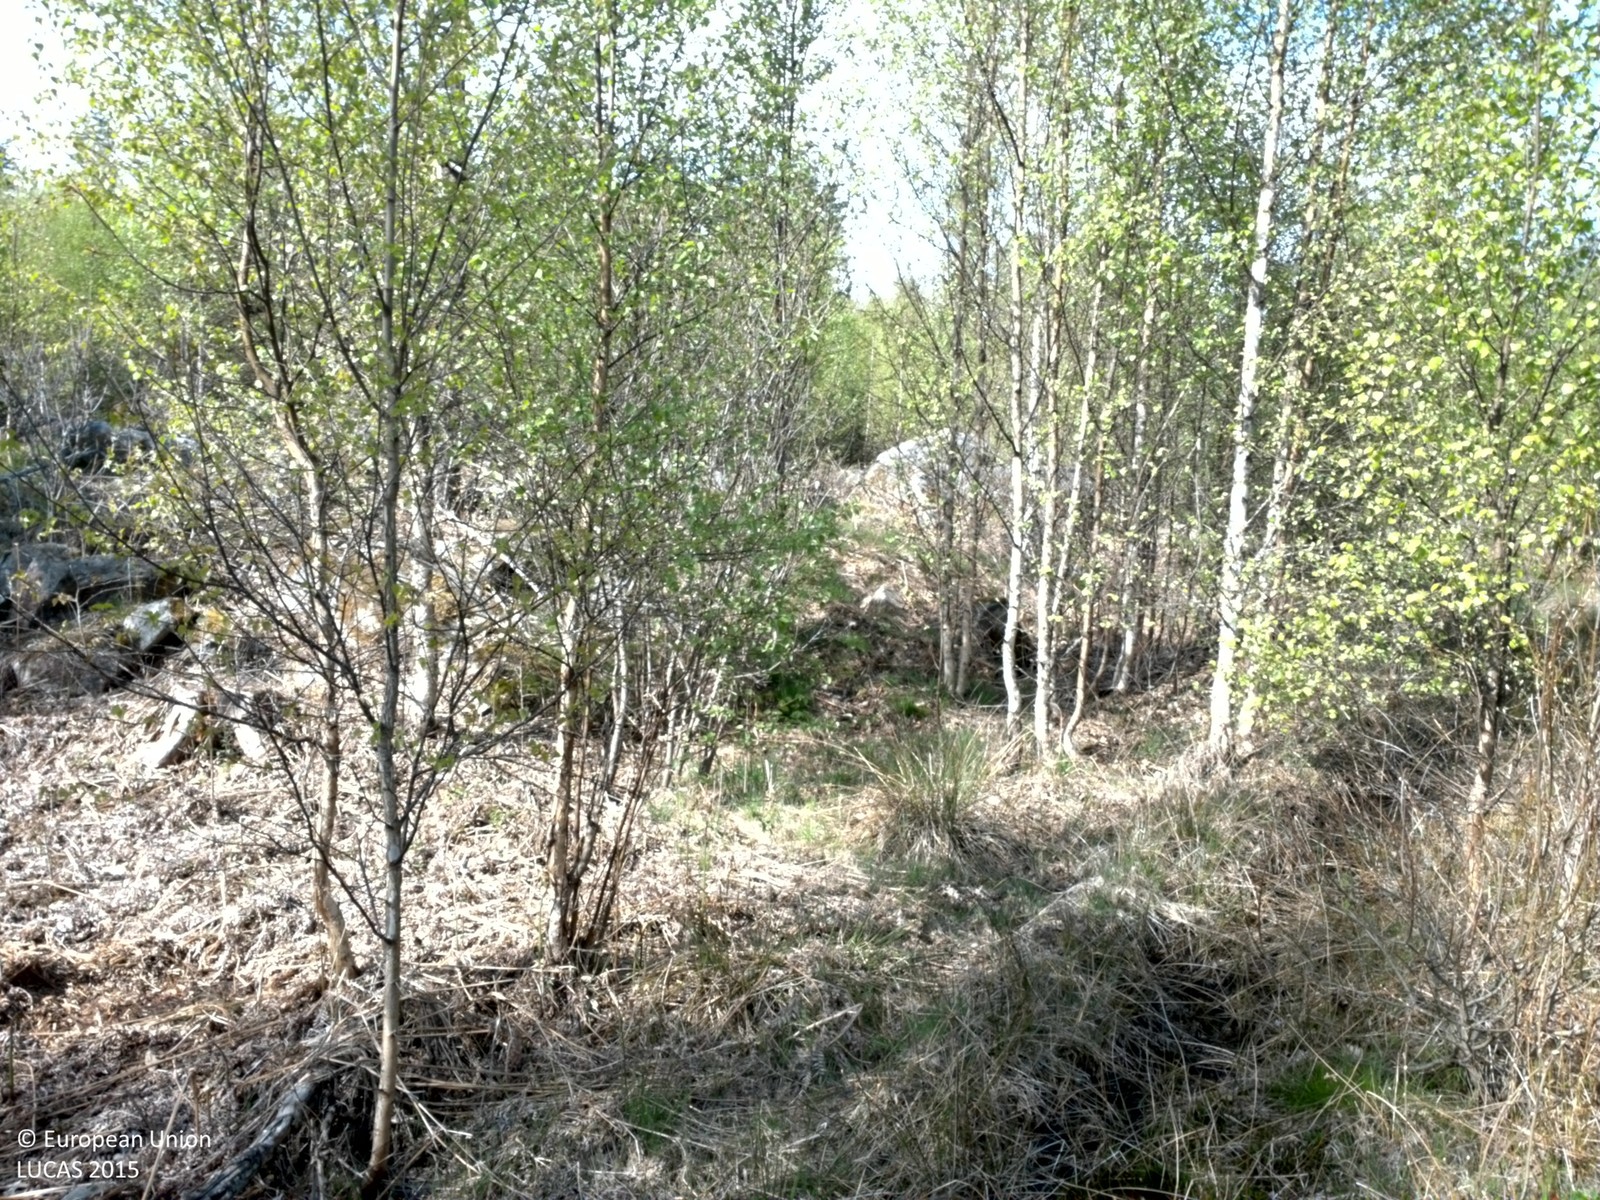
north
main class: Woodland
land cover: Broadleaved woodland
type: boreal forest
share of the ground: > 75 %
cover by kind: broadleaved forest trees 80 %, herbaceous plants 15 %, coniferous forest trees 5 %
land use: Forestry
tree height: > 5 m
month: May
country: SE
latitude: 56.4701
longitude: 15.8273
